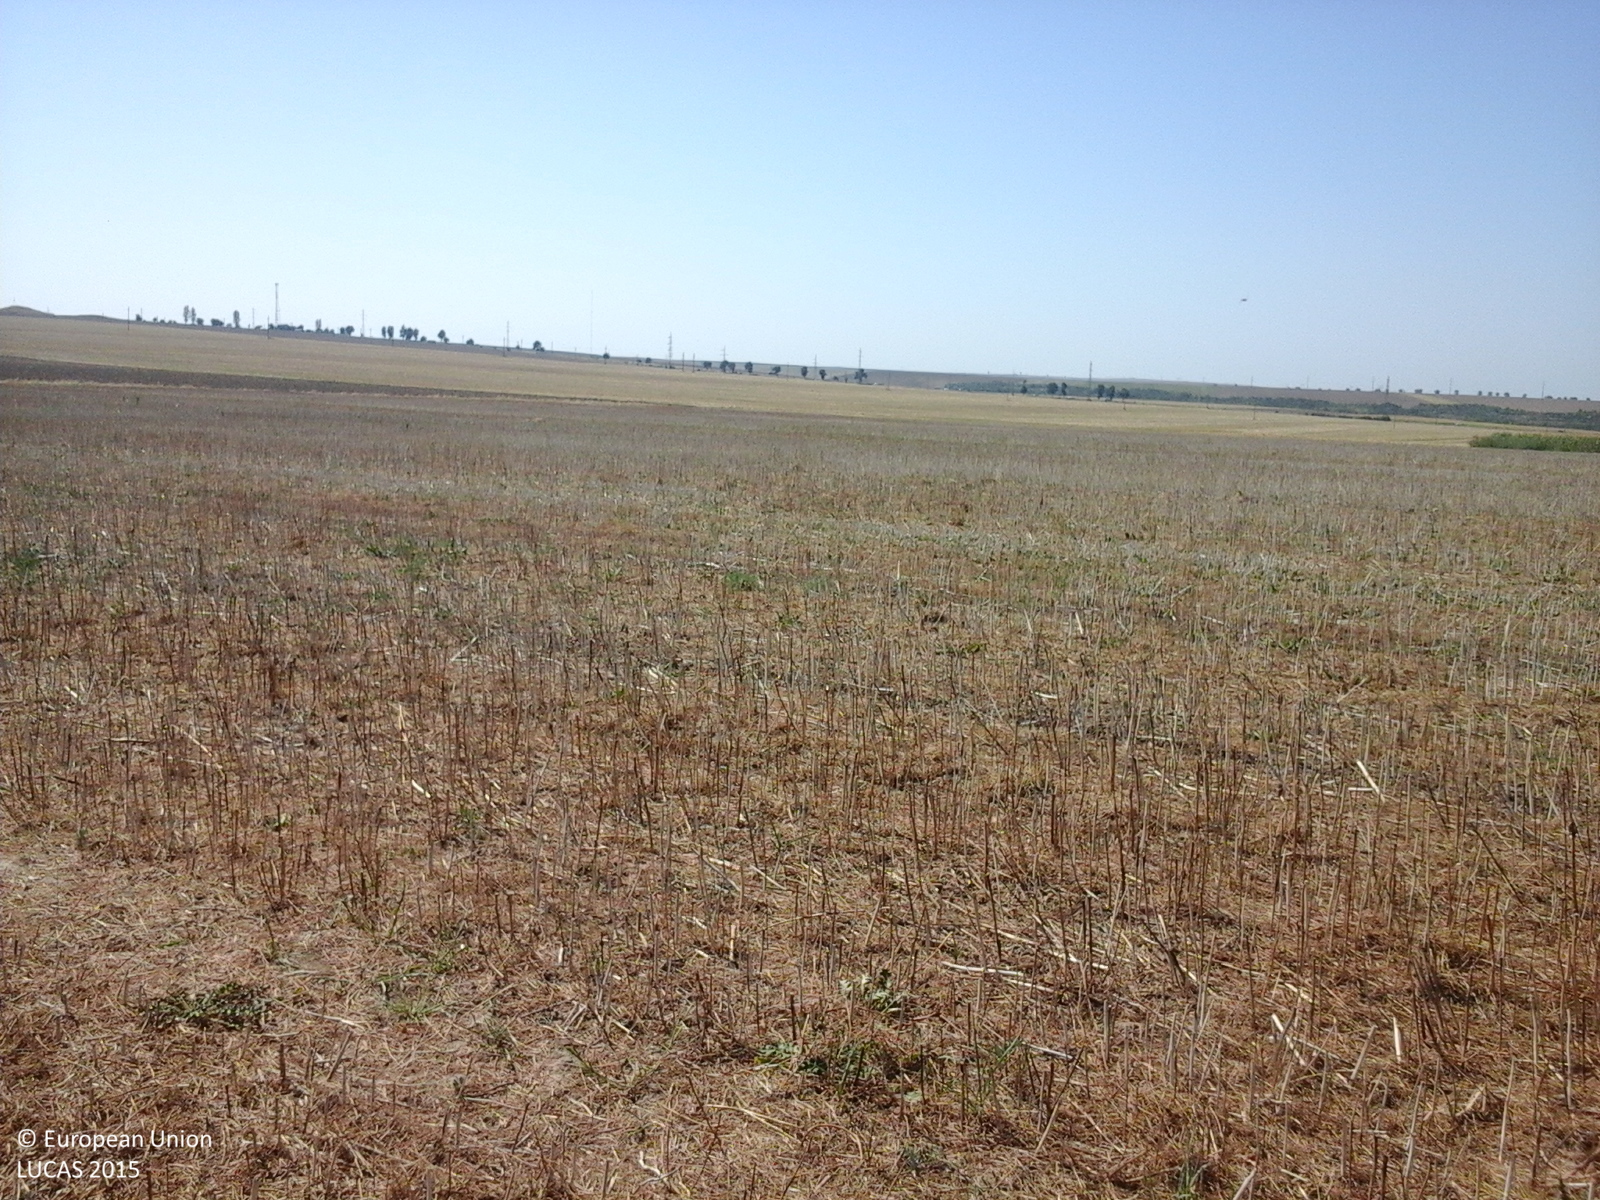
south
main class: Cropland
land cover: Maize
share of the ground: > 75 %
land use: Agriculture (excluding fallow land and kitchen gardens)
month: August
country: RO
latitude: 44.6681
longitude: 28.0599
